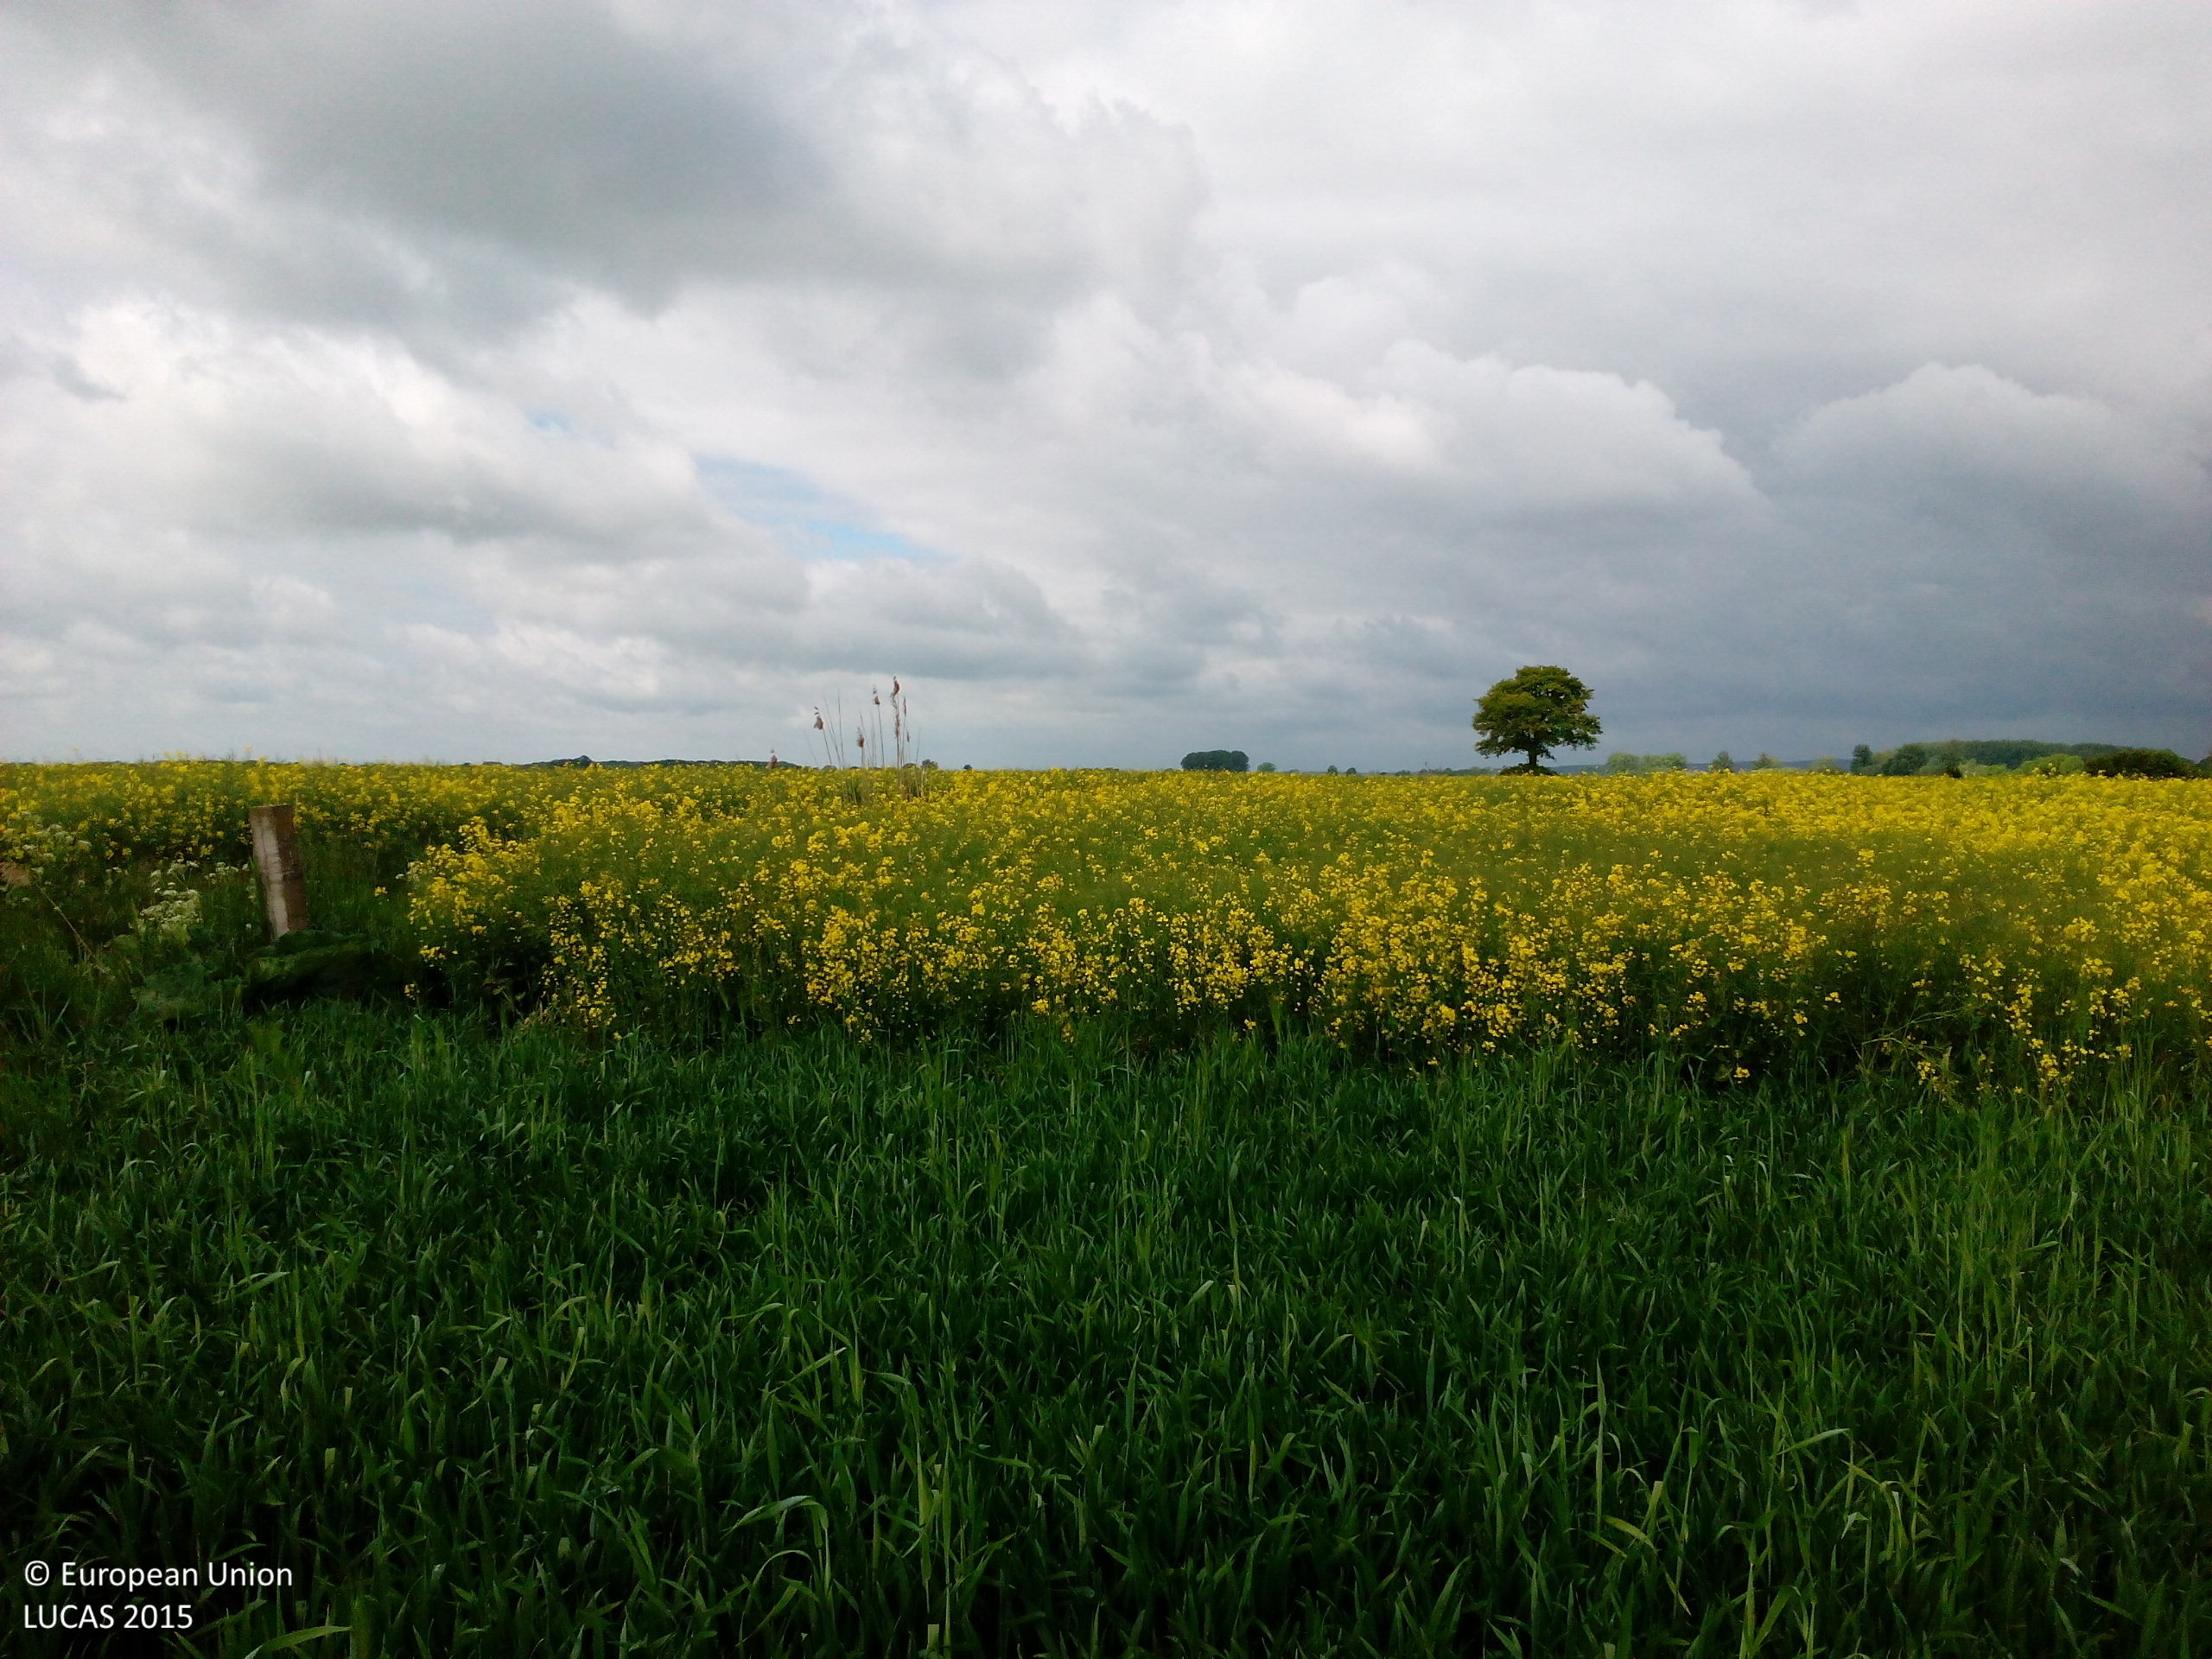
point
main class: Cropland
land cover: Rape and turnip rape
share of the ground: > 75 %
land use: Agriculture (excluding fallow land and kitchen gardens)
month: May
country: DE
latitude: 52.7085
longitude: 11.5832
